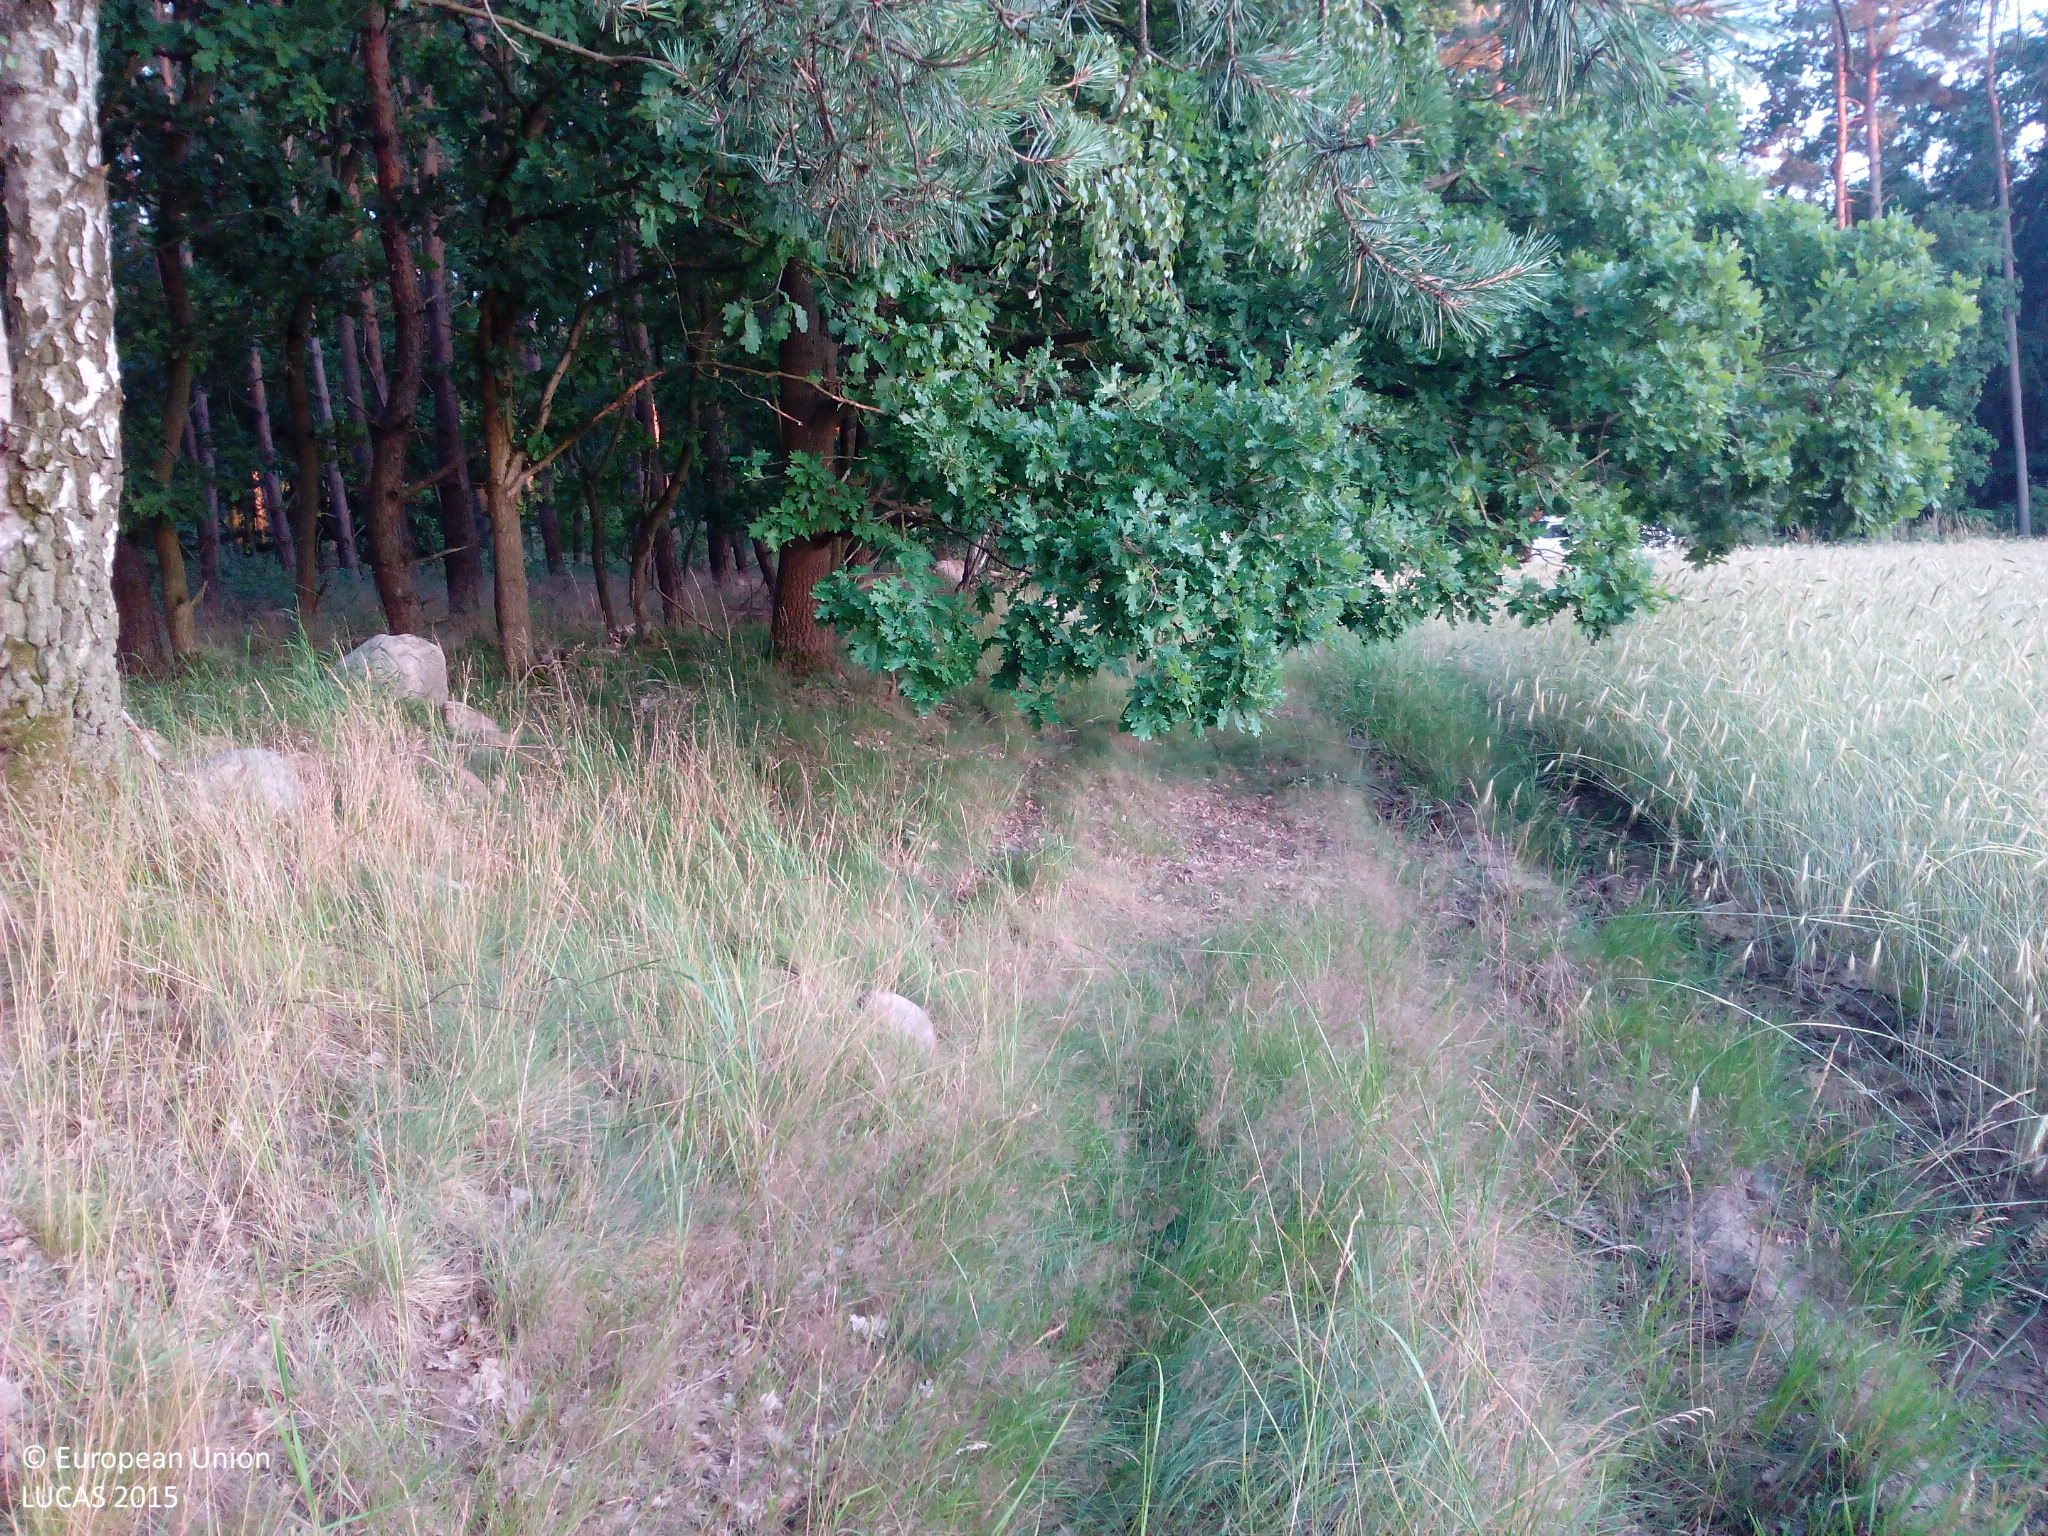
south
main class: Cropland
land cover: Rye
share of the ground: 50 - 75 %
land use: Agriculture (excluding fallow land and kitchen gardens)
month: July
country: DE
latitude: 53.5089
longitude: 14.2075
